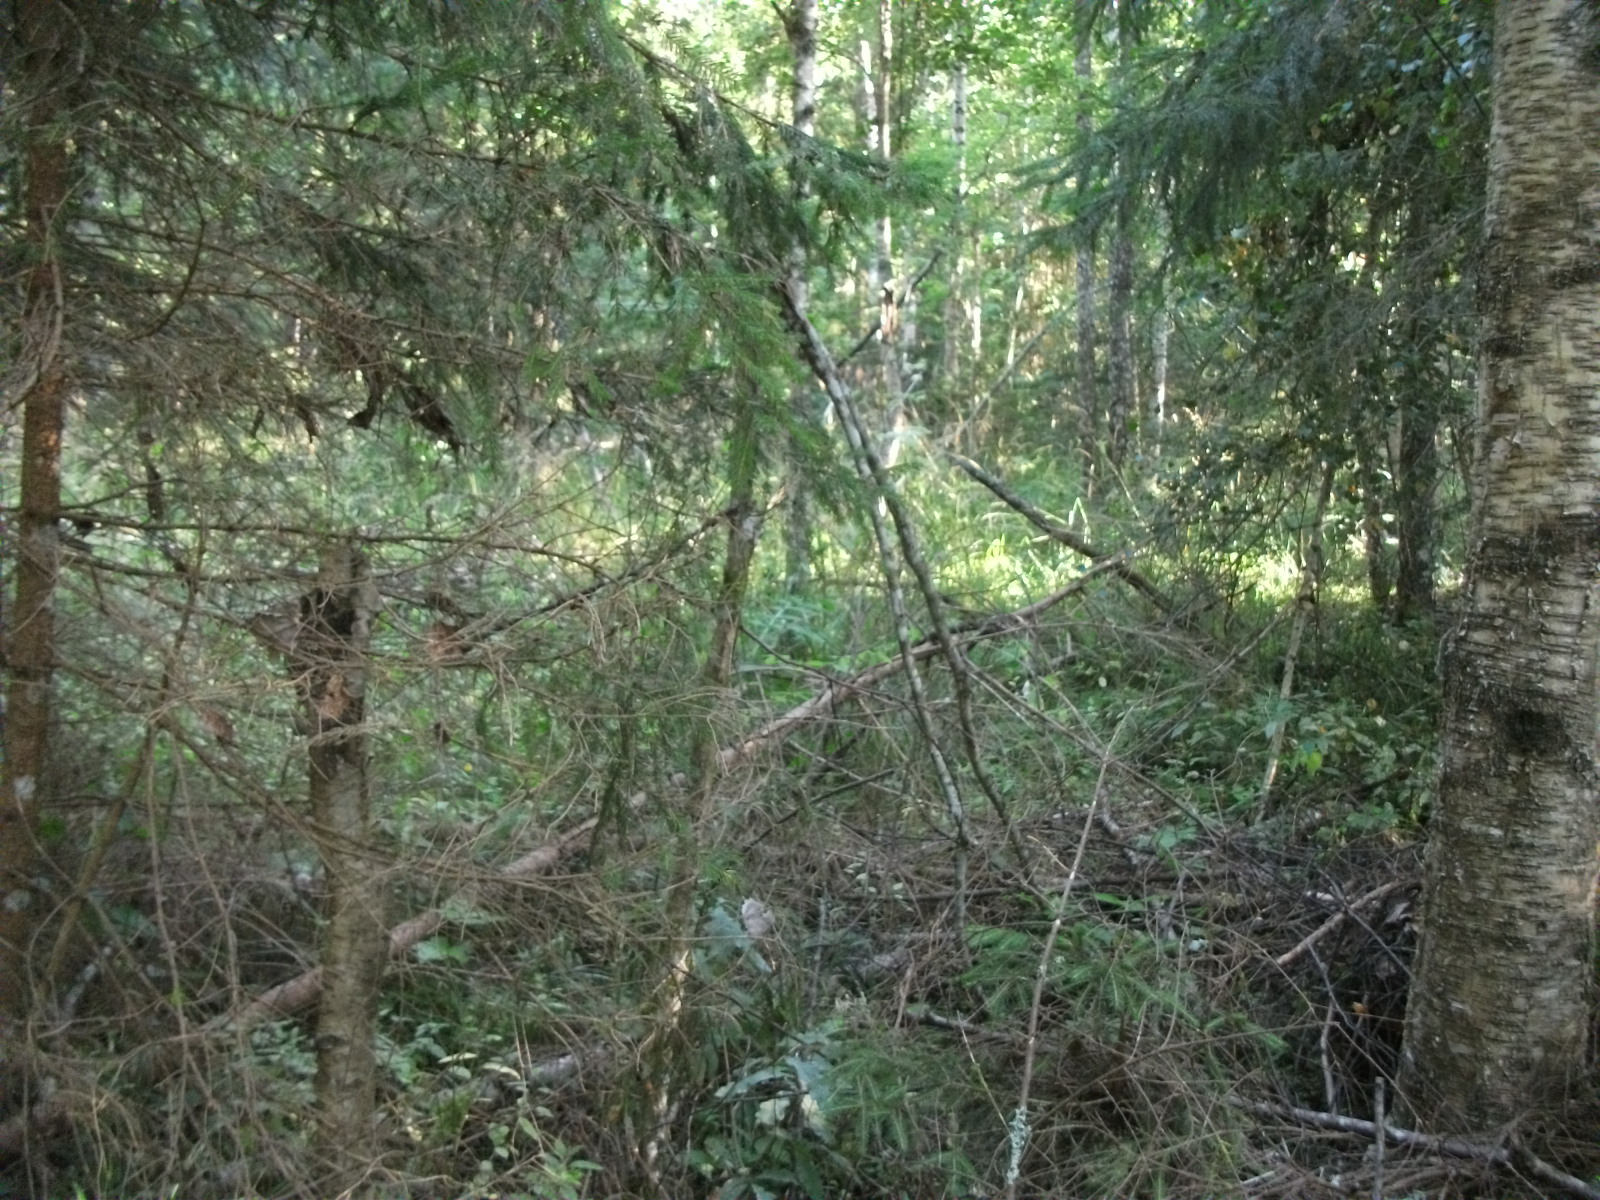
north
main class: Woodland
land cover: Spruce dominated mixed woodland
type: hemiboreal forest and nemoral coniferous forest and mixed broadleaved-coniferous forest
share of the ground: > 75 %
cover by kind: coniferous forest trees 50 %, broadleaved forest trees 30 %, herbaceous plants 15 %, shrubs 5 %
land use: Forestry
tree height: > 5 m
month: August
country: LV
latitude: 56.7098
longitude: 26.4988
